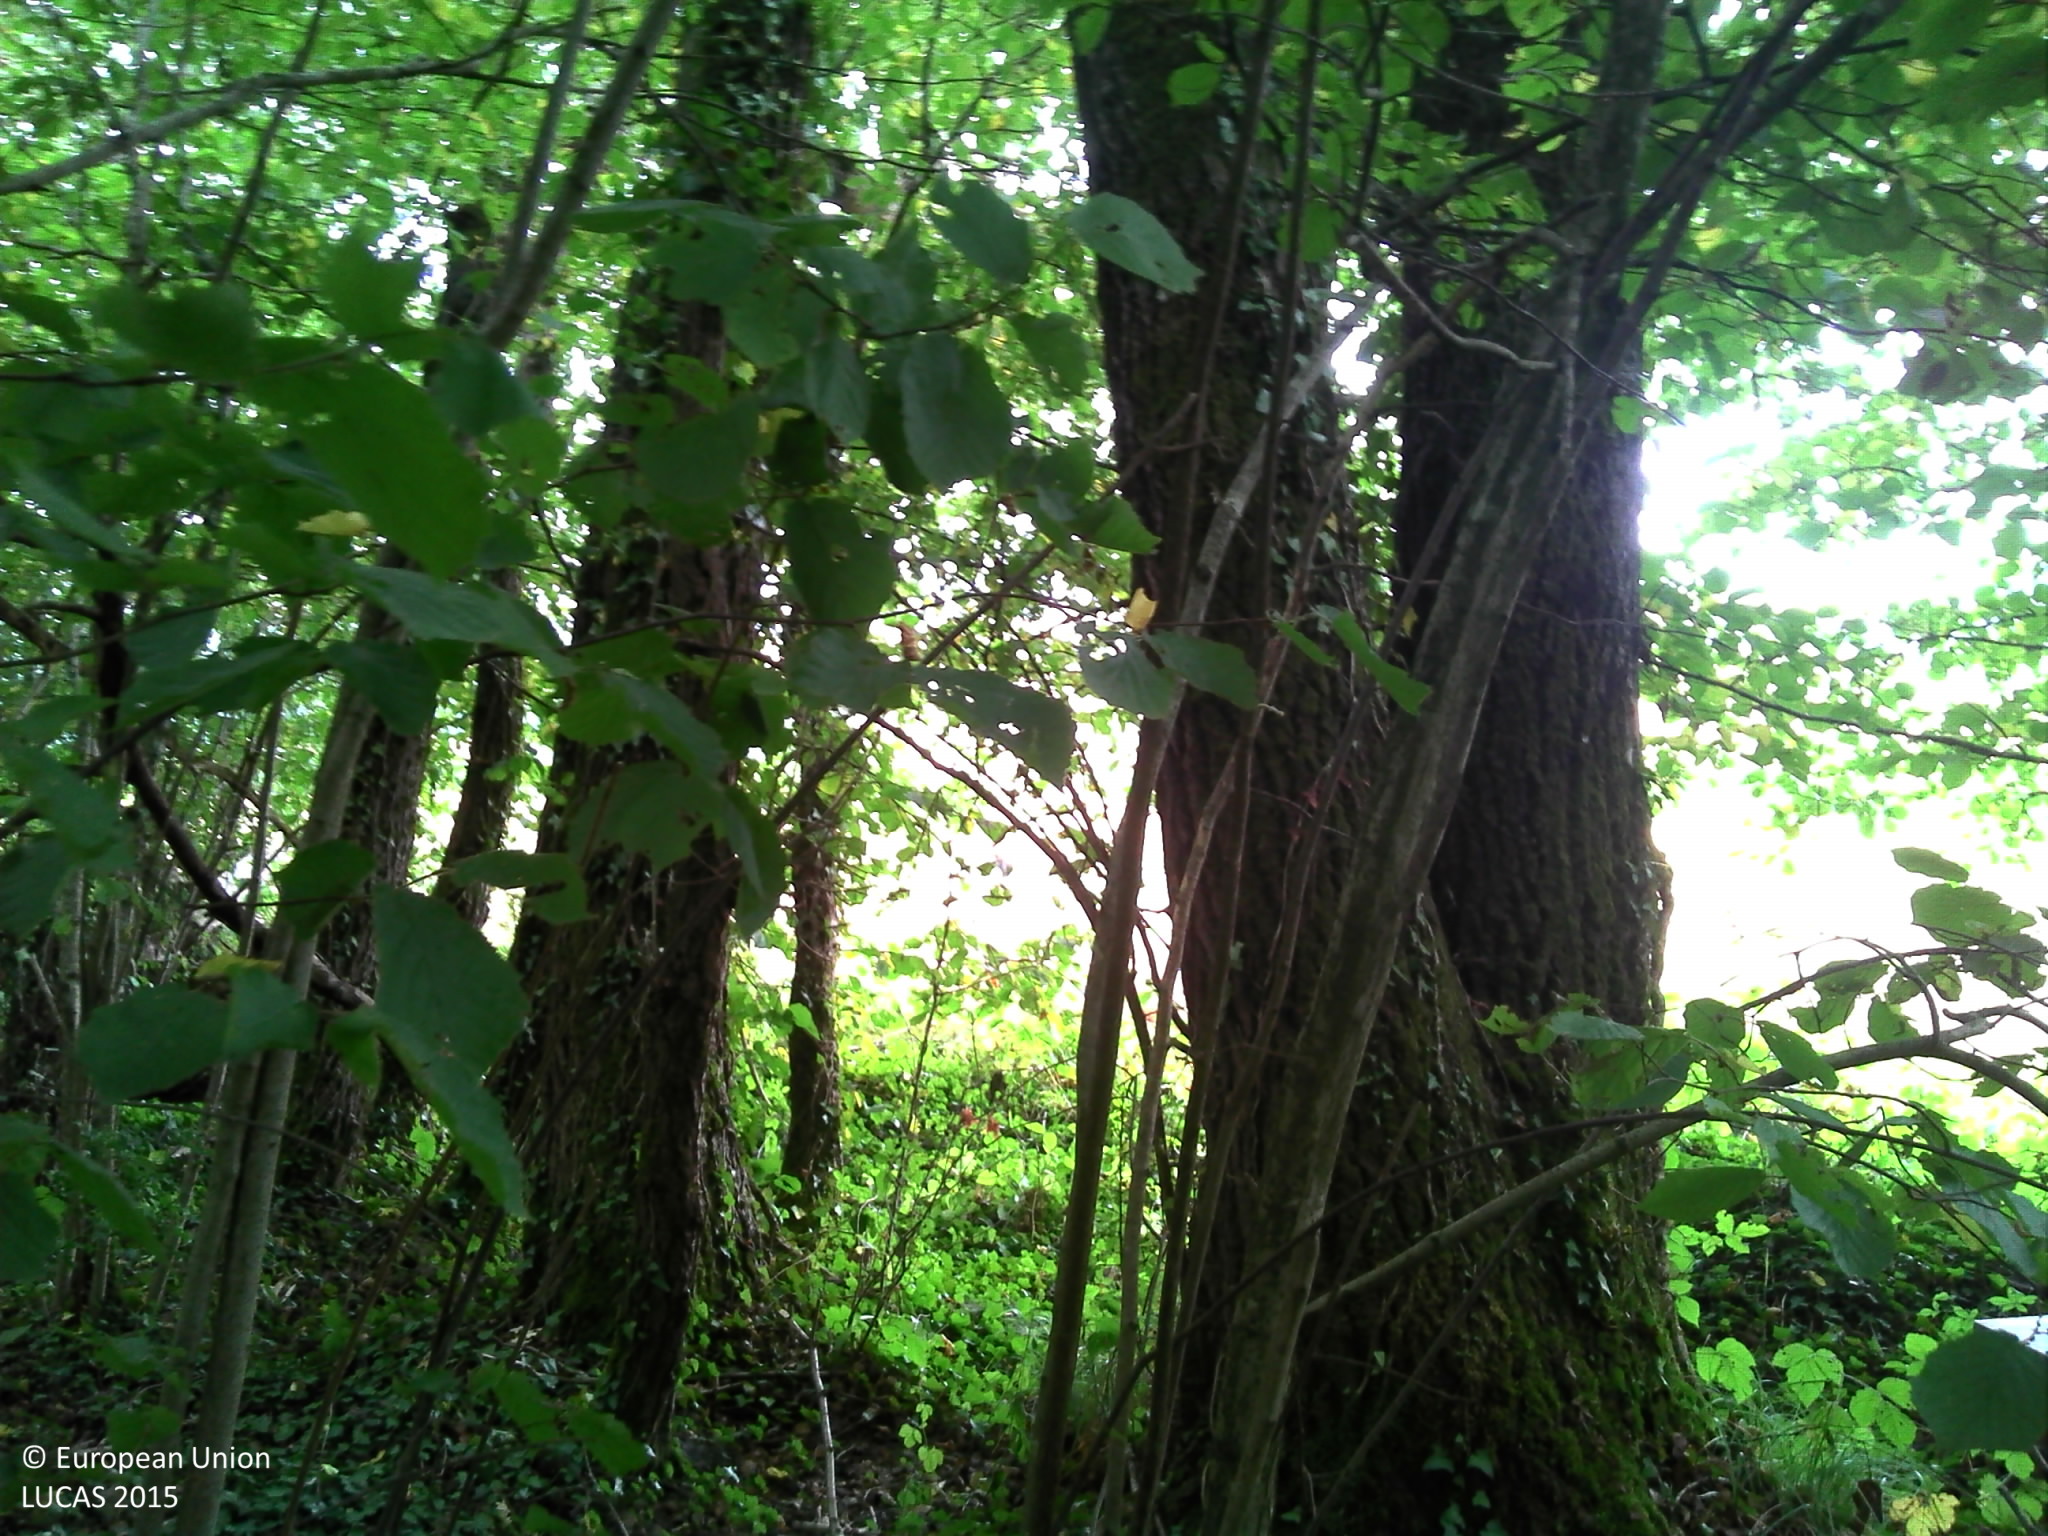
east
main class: Woodland
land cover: Broadleaved woodland
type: mesophytic deciduous forest
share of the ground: > 75 %
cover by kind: broadleaved forest trees 40 %, herbaceous plants 35 %, unconsolidated bare surface 15 %, lichens and mosses 5 %
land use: Forestry
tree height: > 5 m
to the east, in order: Broadleaved woodland; Grassland without tree/shrub cover; Tracks; Grass margins; Vineyards; Tracks; Vineyards; Tracks; Vineyards
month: August
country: FR
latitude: 49.2174
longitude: 3.7198
